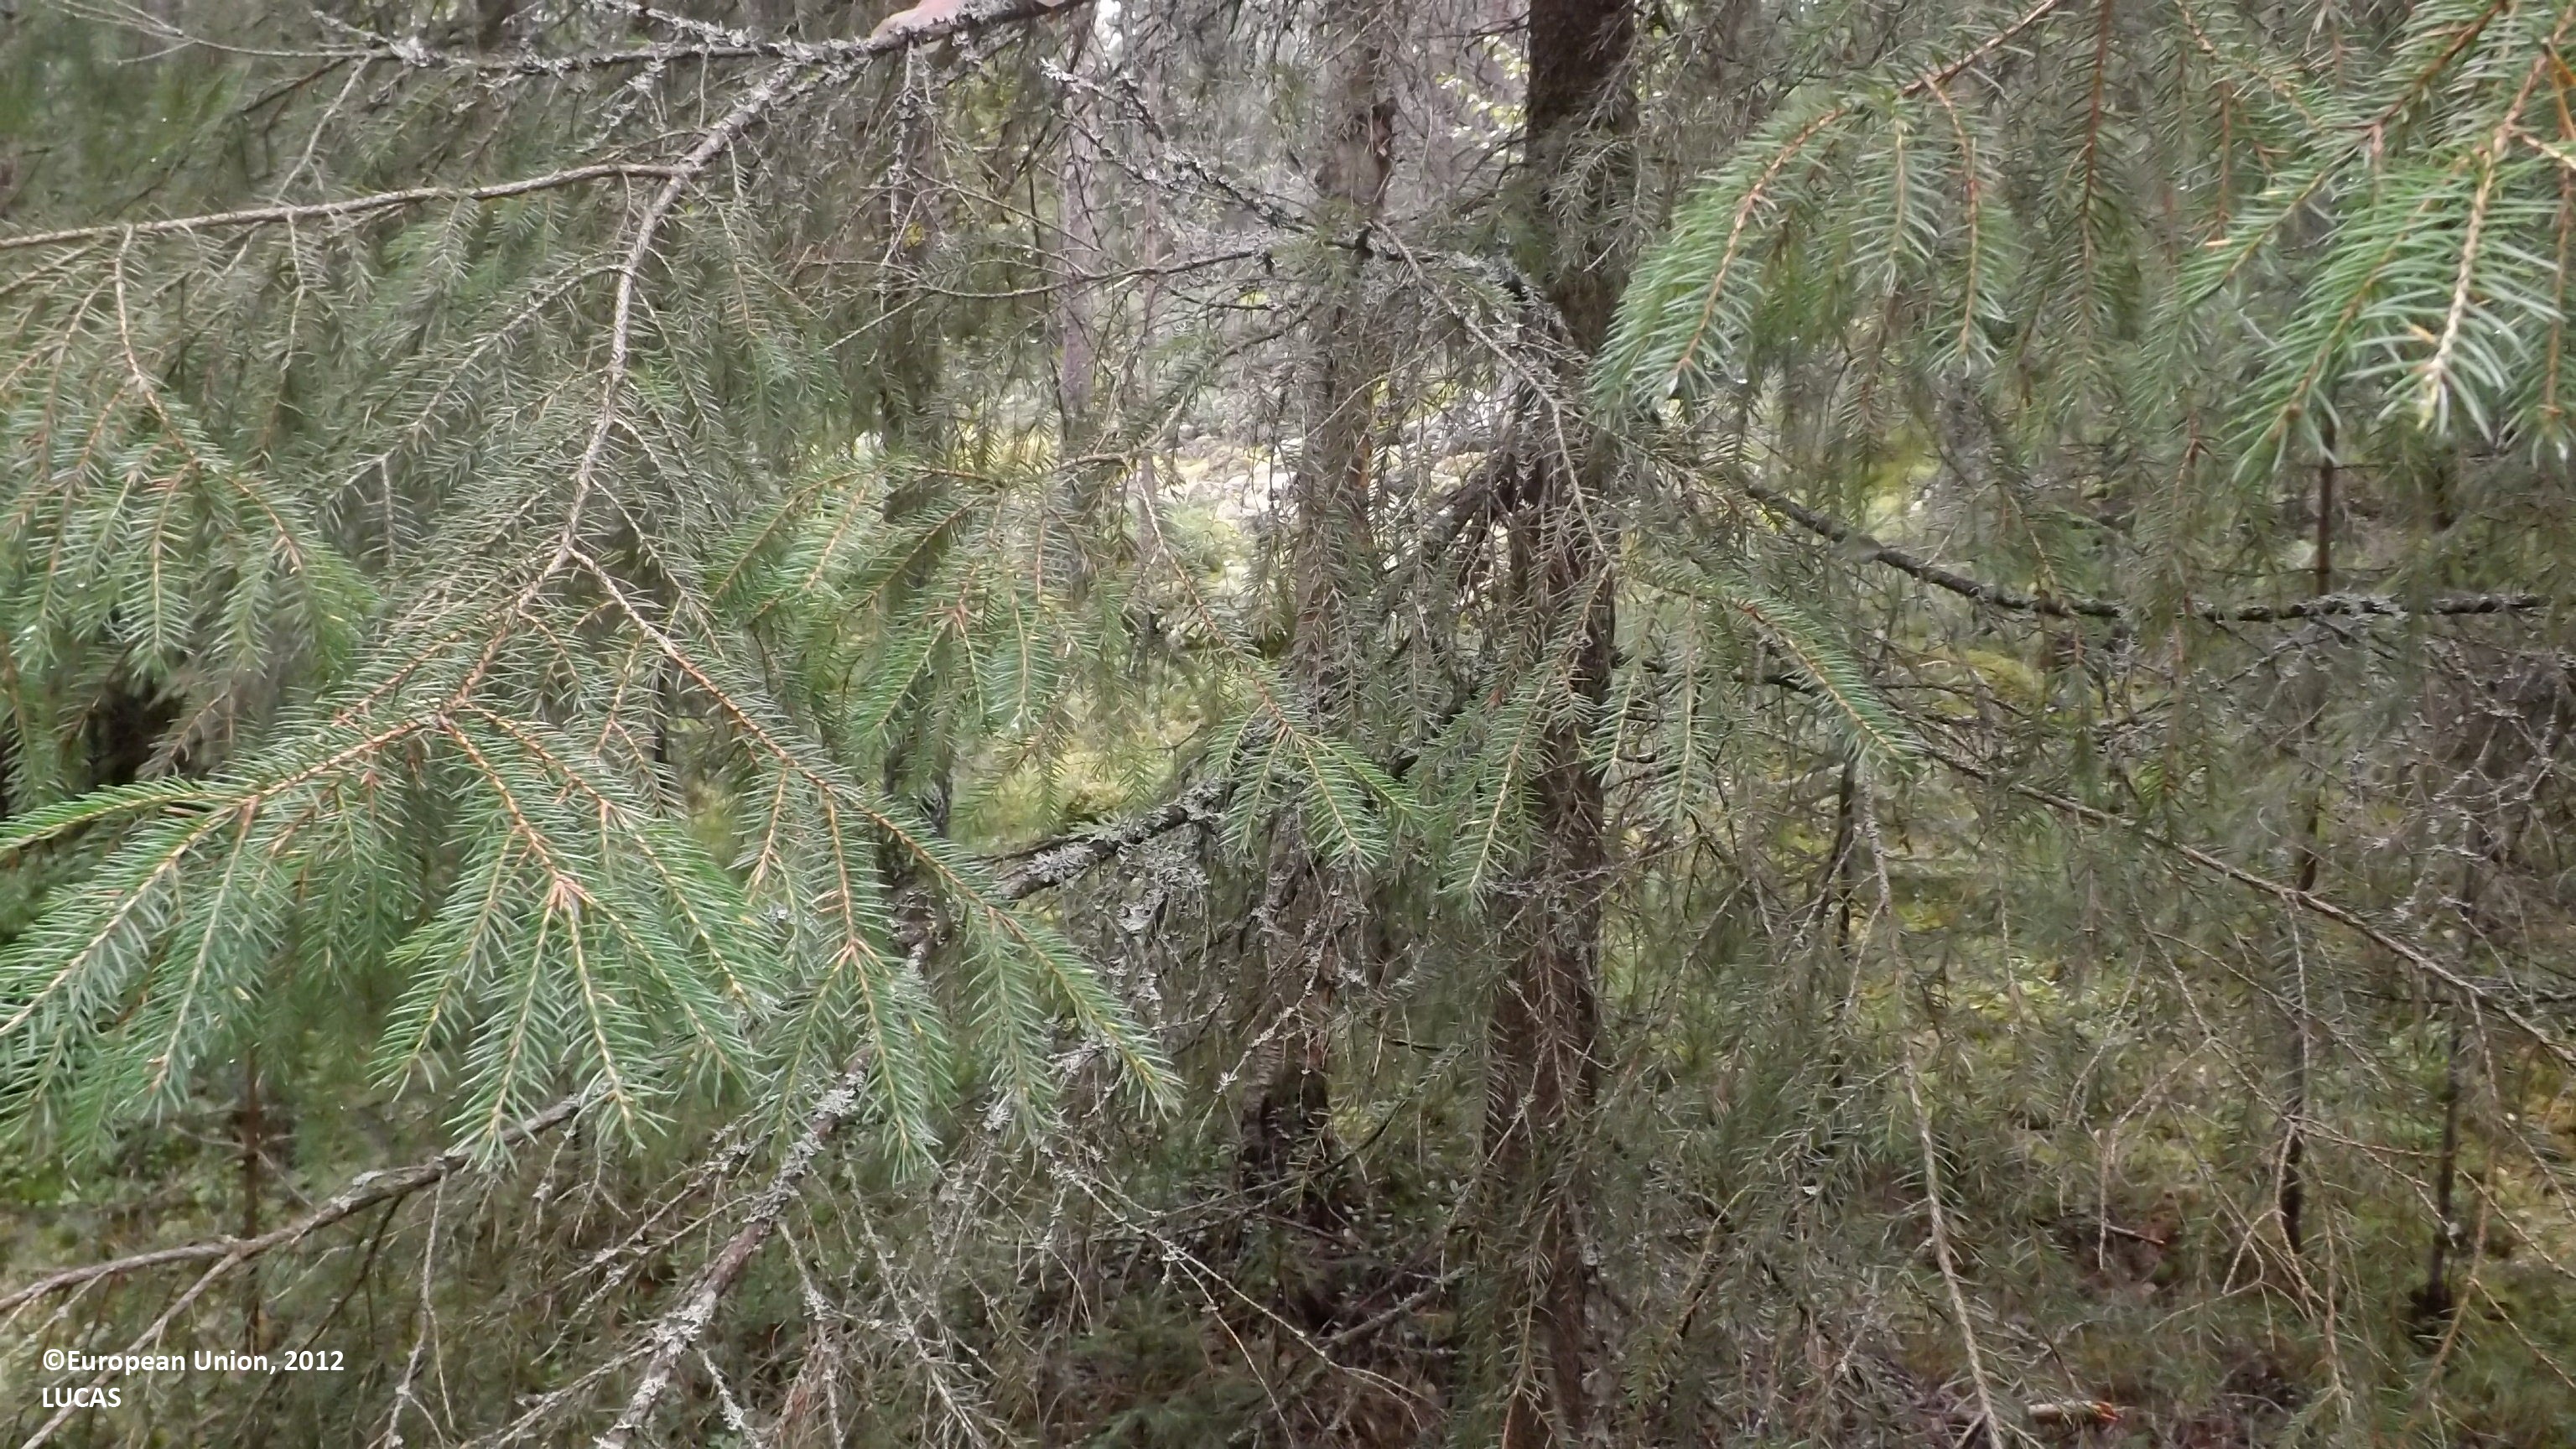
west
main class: Woodland
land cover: Other mixed woodland
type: boreal forest
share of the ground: 50 - 75 %
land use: Forestry
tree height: > 5 m
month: August
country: FI
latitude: 63.7697
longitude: 23.4220
